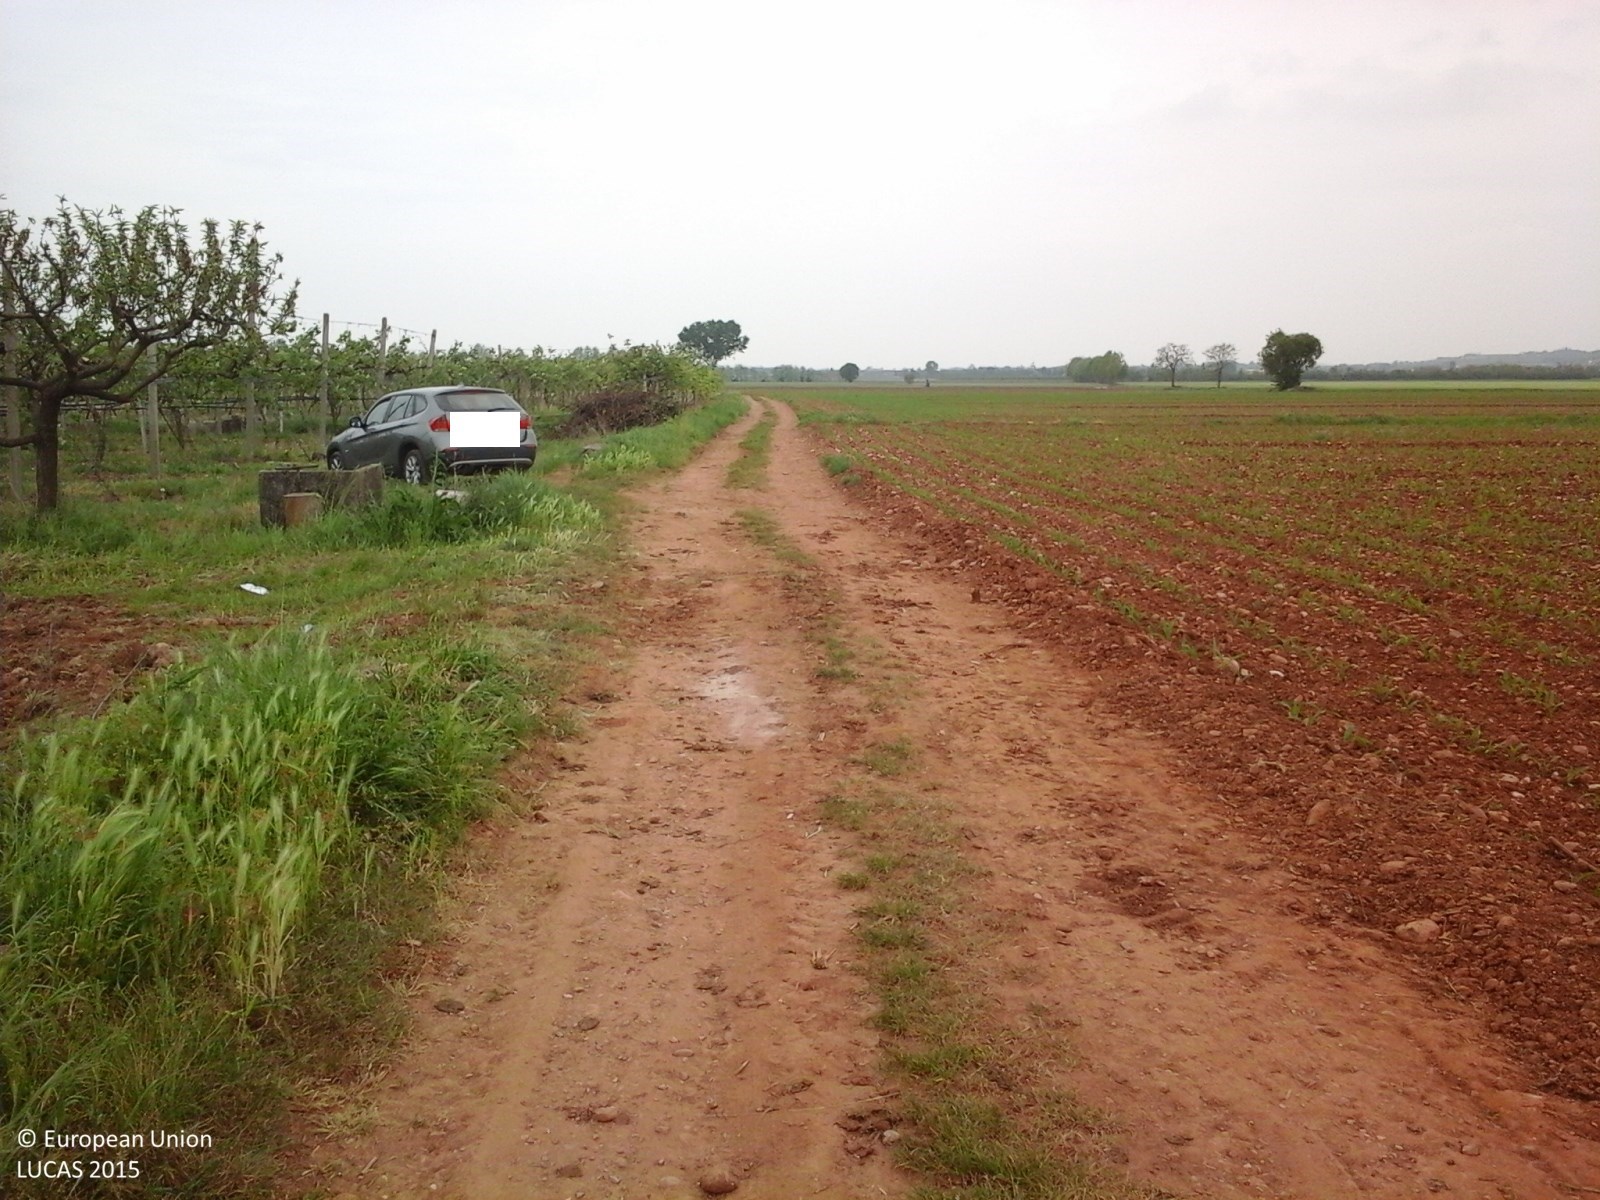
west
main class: Cropland
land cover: Maize
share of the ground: < 10 %
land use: Agriculture (excluding fallow land and kitchen gardens)
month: April
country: IT
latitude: 45.3223
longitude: 10.6240
